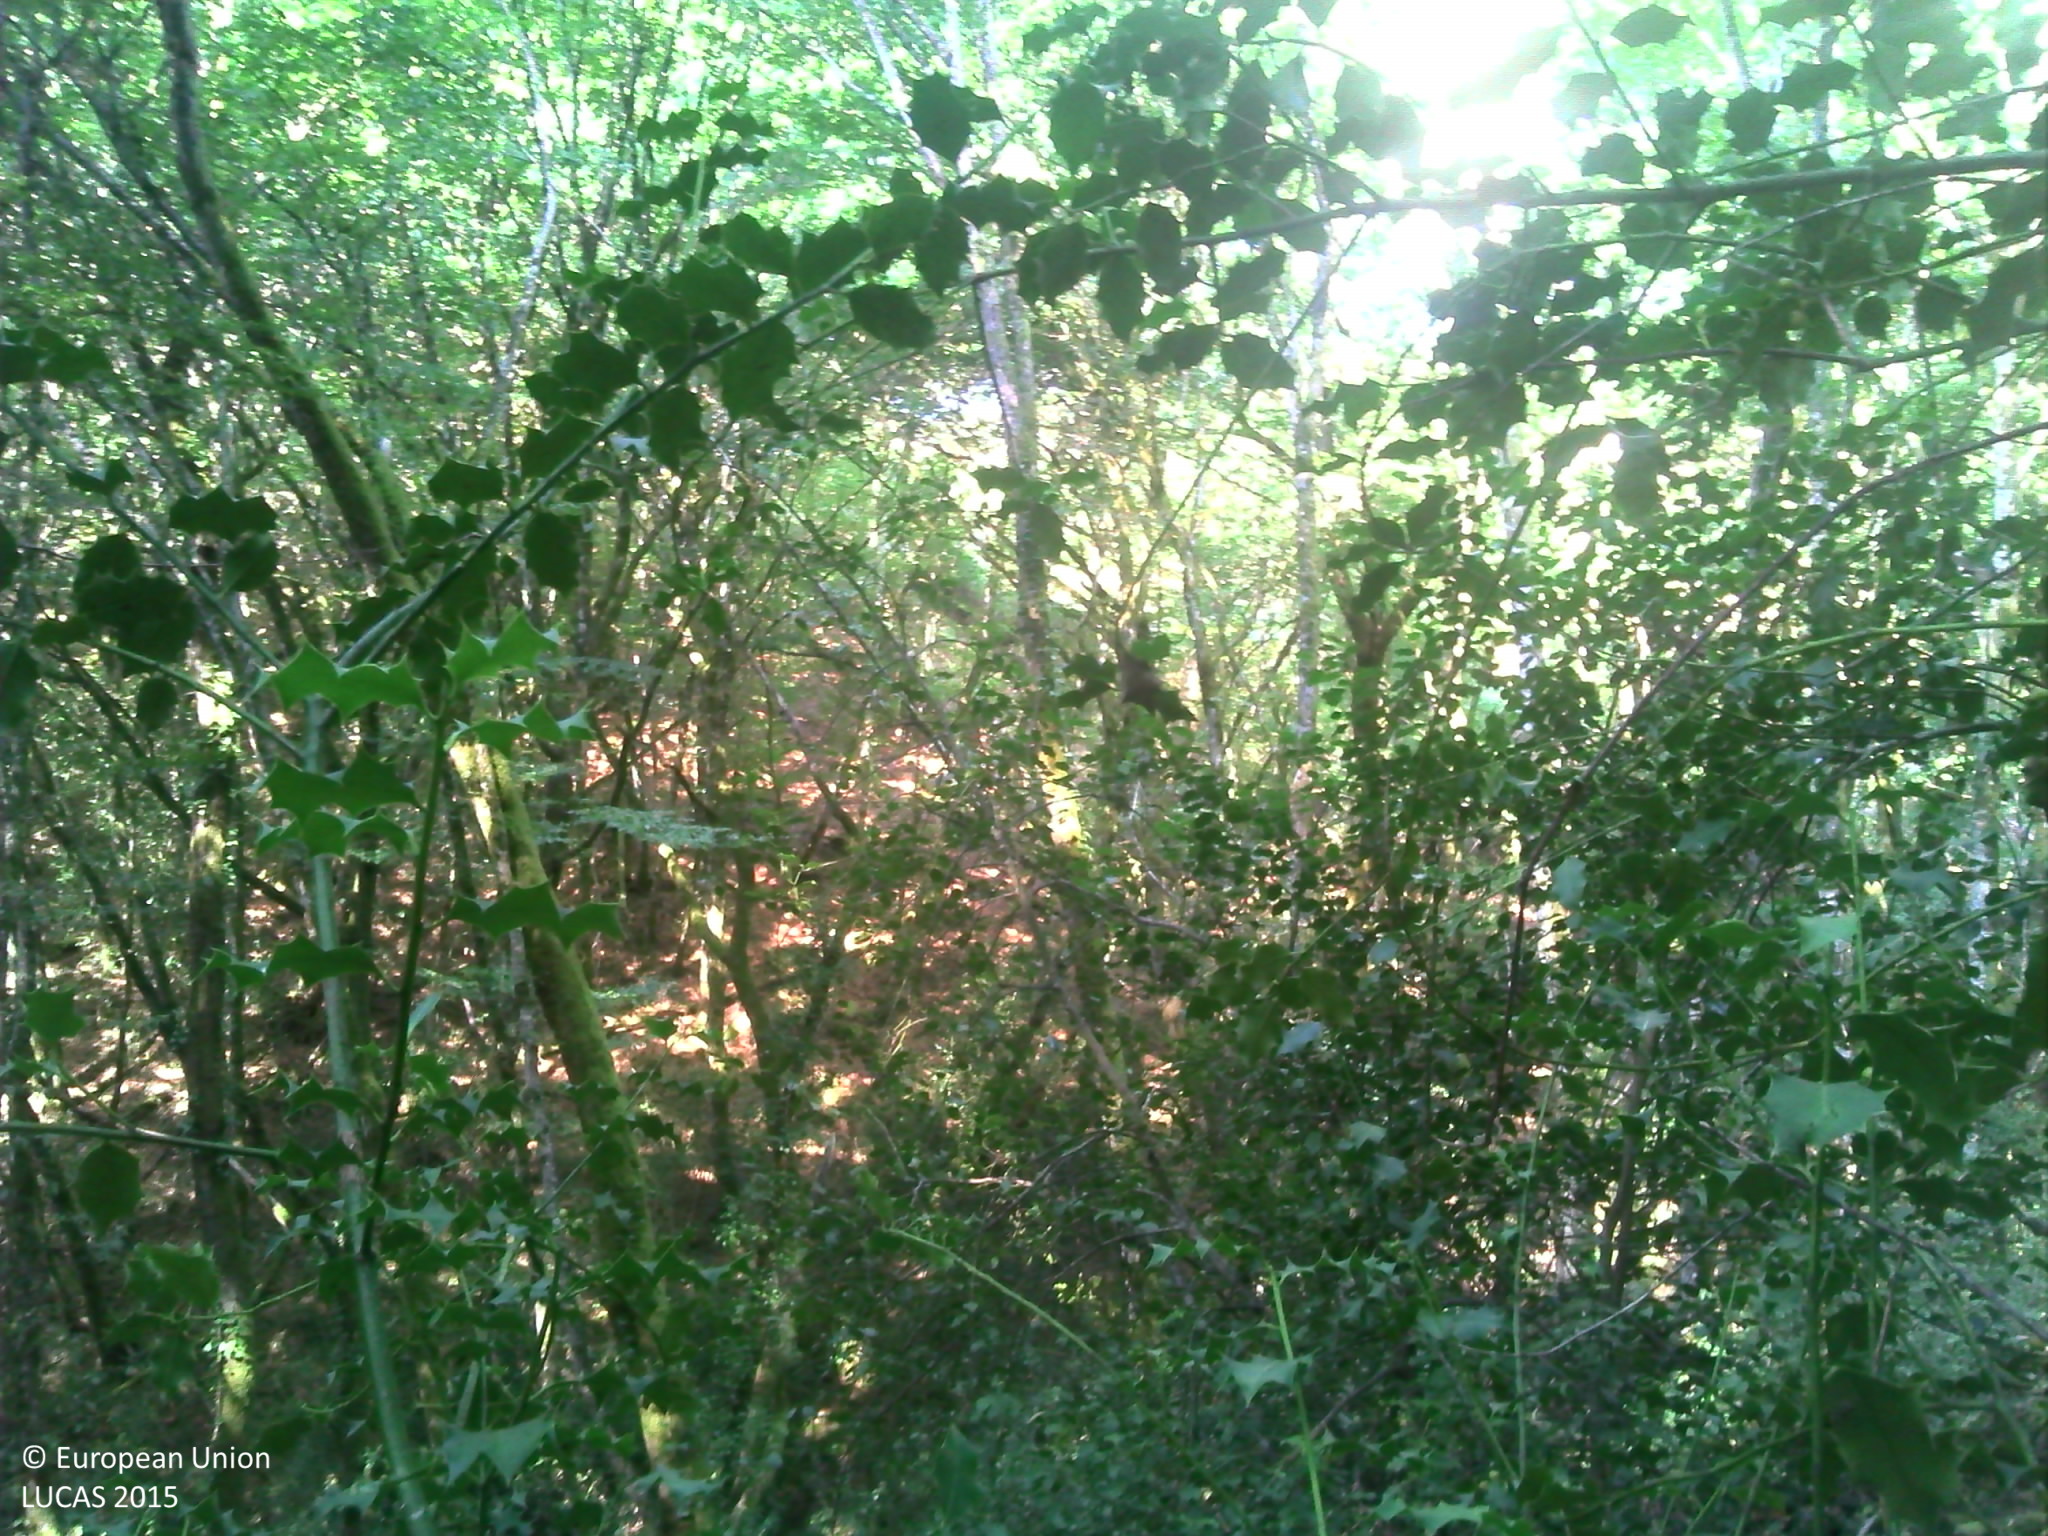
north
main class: Woodland
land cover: Broadleaved woodland
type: mesophytic deciduous forest
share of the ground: 50 - 75 %
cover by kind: broadleaved forest trees 80 %, herbaceous plants 20 %
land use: Forestry
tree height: > 5 m
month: August
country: FR
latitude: 45.3690
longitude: 1.8372
